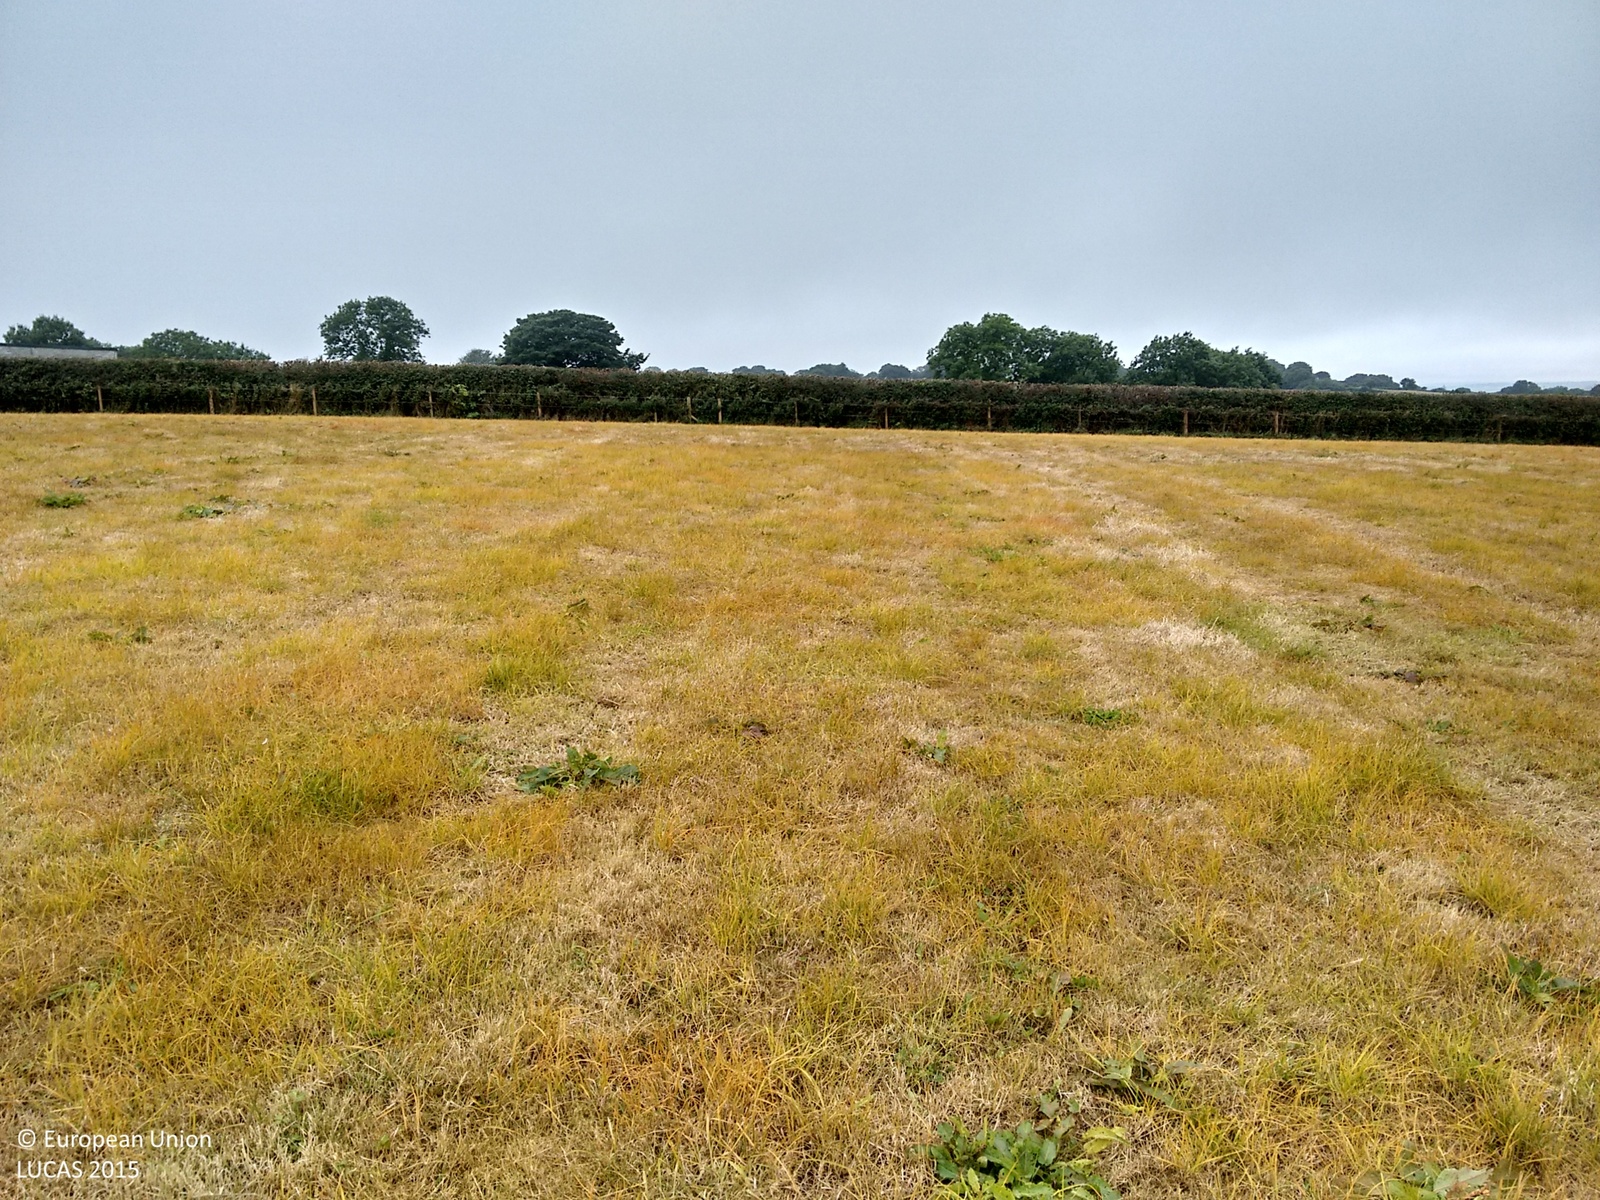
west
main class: Grassland
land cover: Grassland without tree/shrub cover
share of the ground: > 75 %
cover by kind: herbaceous plants 100 %
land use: Agriculture (excluding fallow land and kitchen gardens)
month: August
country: GB
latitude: 51.7836
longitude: -4.7076
